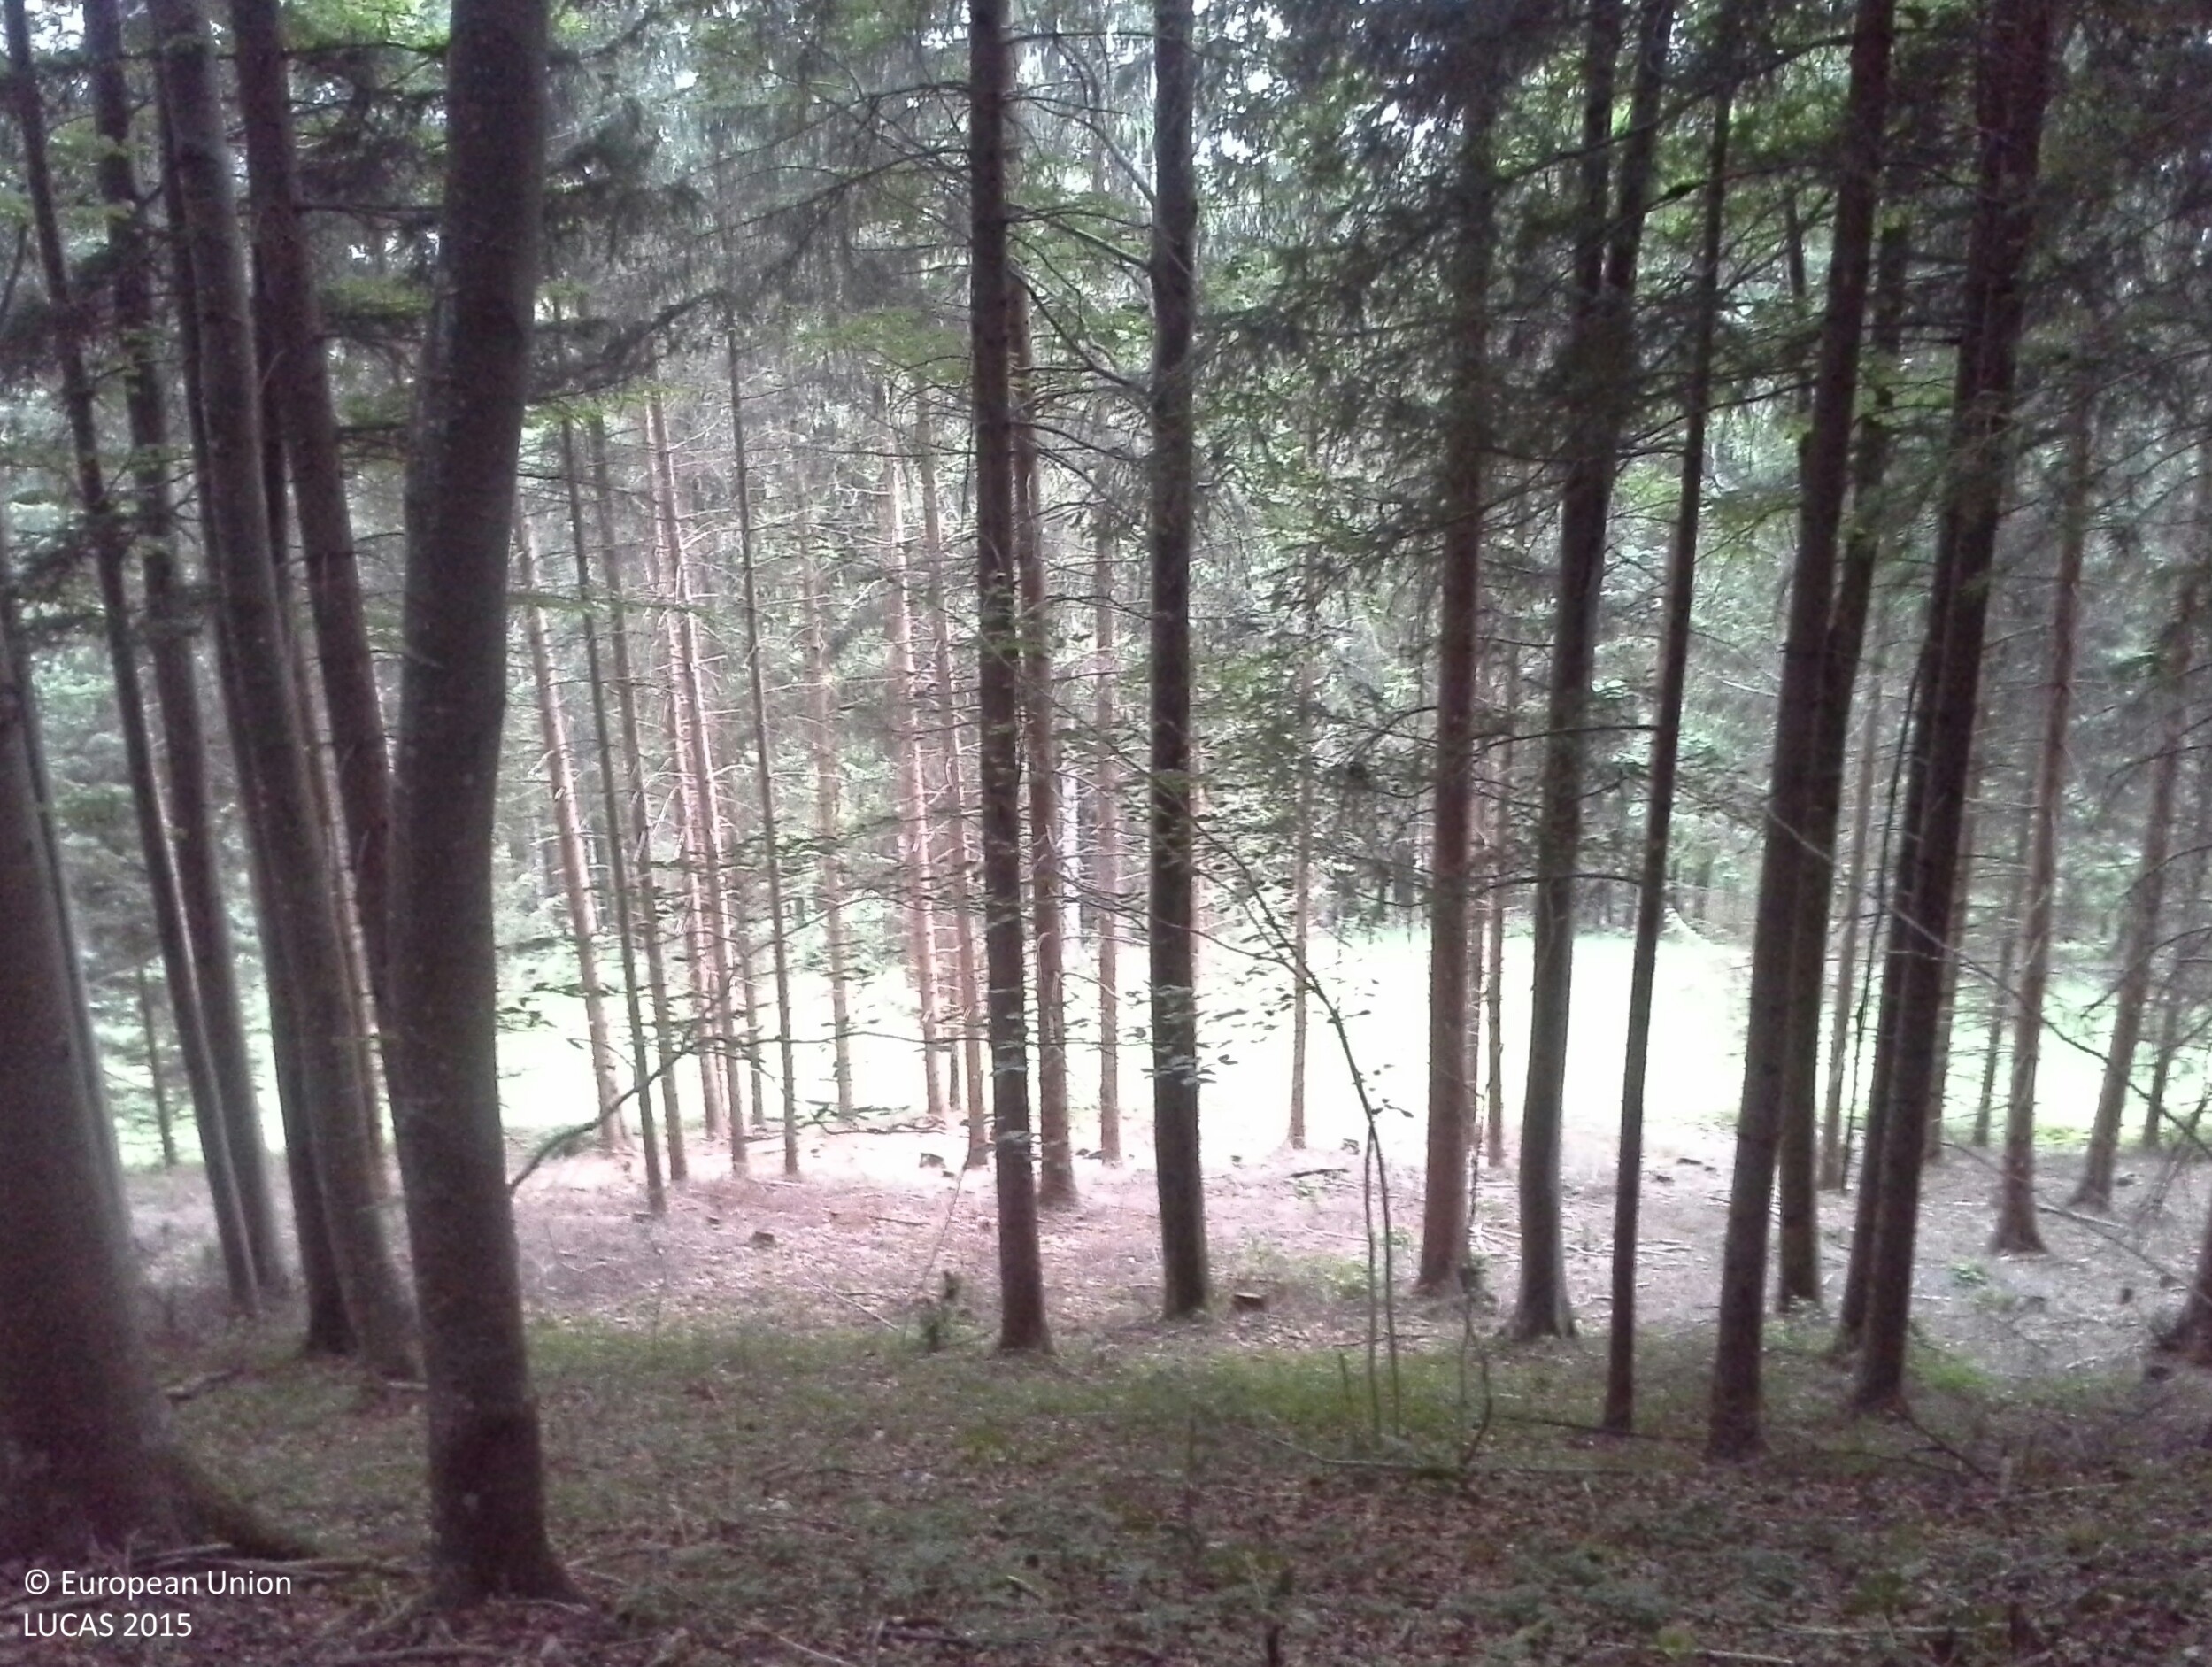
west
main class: Woodland
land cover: Broadleaved woodland
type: beech forest
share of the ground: > 75 %
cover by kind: broadleaved forest trees 80 %, coniferous forest trees 20 %
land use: Forestry
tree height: > 5 m
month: July
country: AT
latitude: 47.8533
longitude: 14.6911
